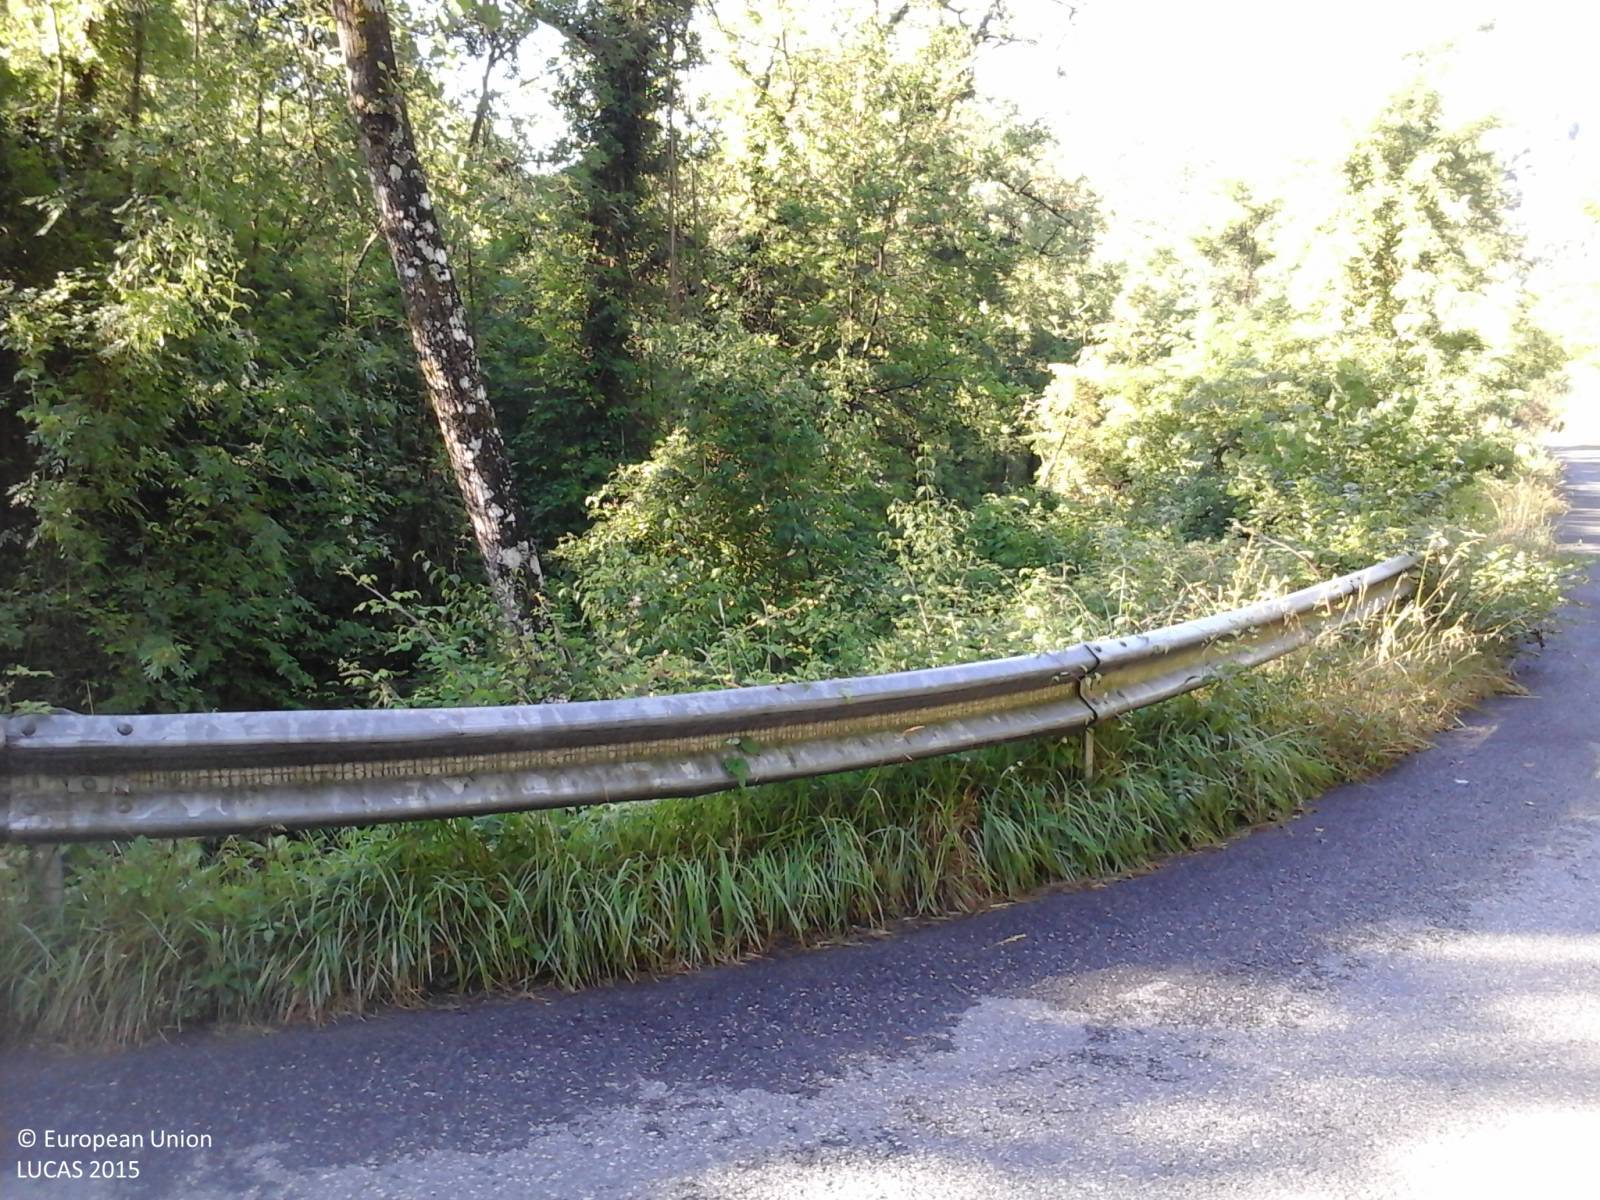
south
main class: Woodland
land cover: Broadleaved woodland
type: thermophilous deciduous forest
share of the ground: > 75 %
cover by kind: broadleaved forest trees 100 %
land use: Forestry
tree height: > 5 m
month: June
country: IT
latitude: 44.2603
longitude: 9.9125
